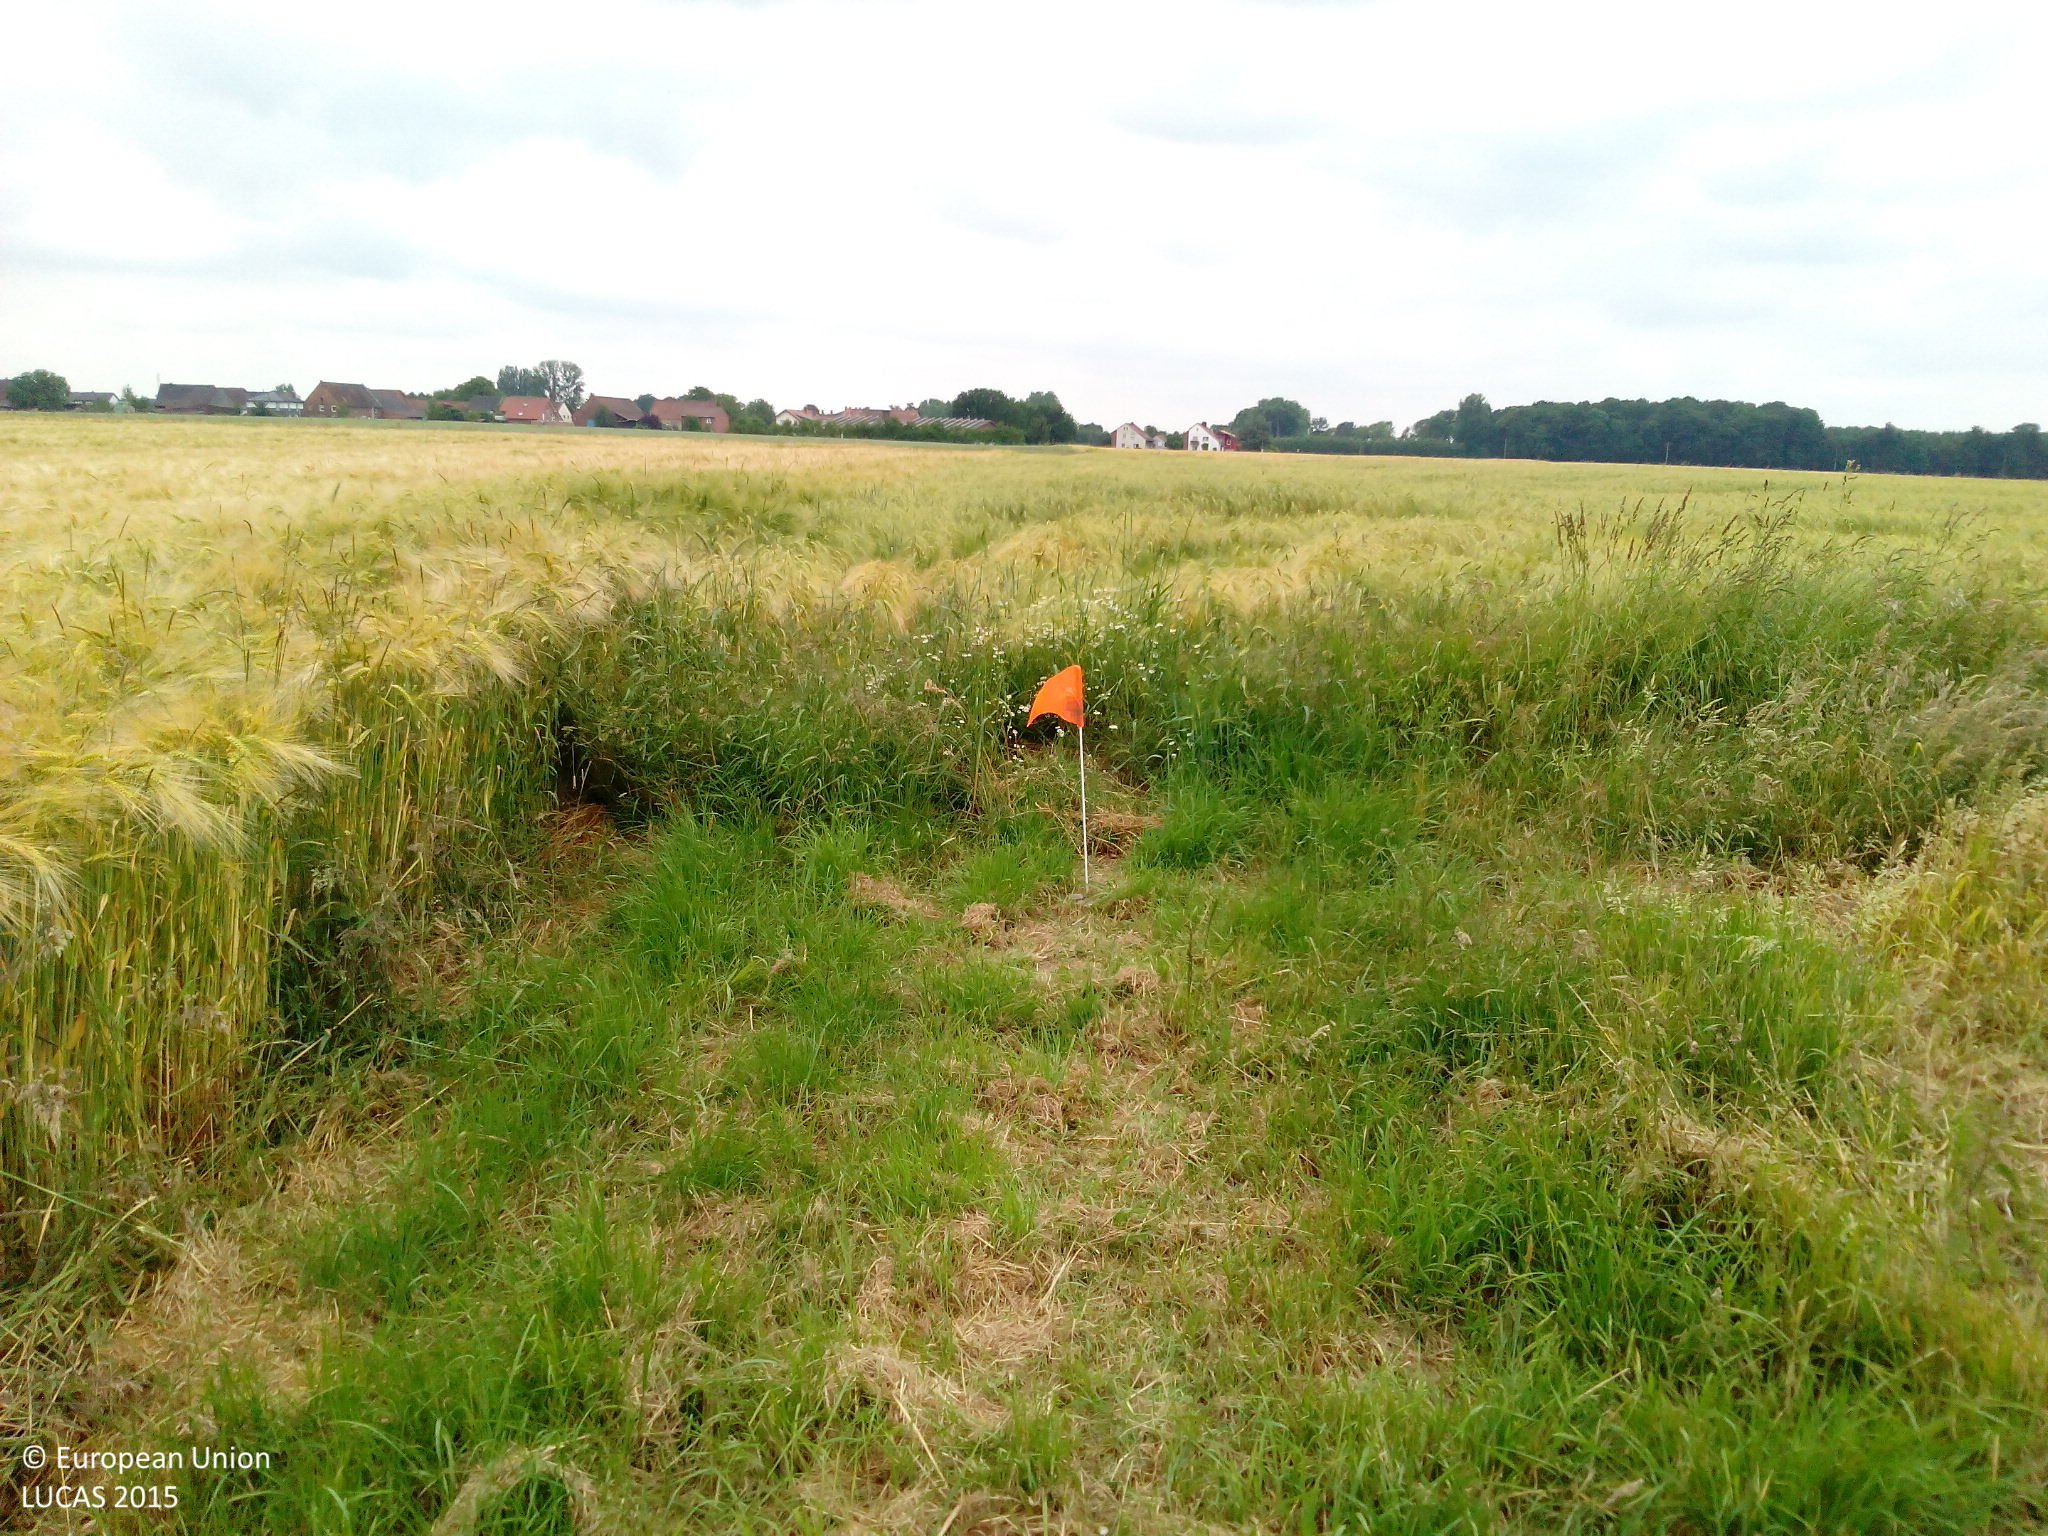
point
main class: Grassland
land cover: Grassland without tree/shrub cover
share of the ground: > 75 %
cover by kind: herbaceous plants 100 %
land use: Agriculture (excluding fallow land and kitchen gardens)
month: June
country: DE
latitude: 51.6479
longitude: 8.4251
